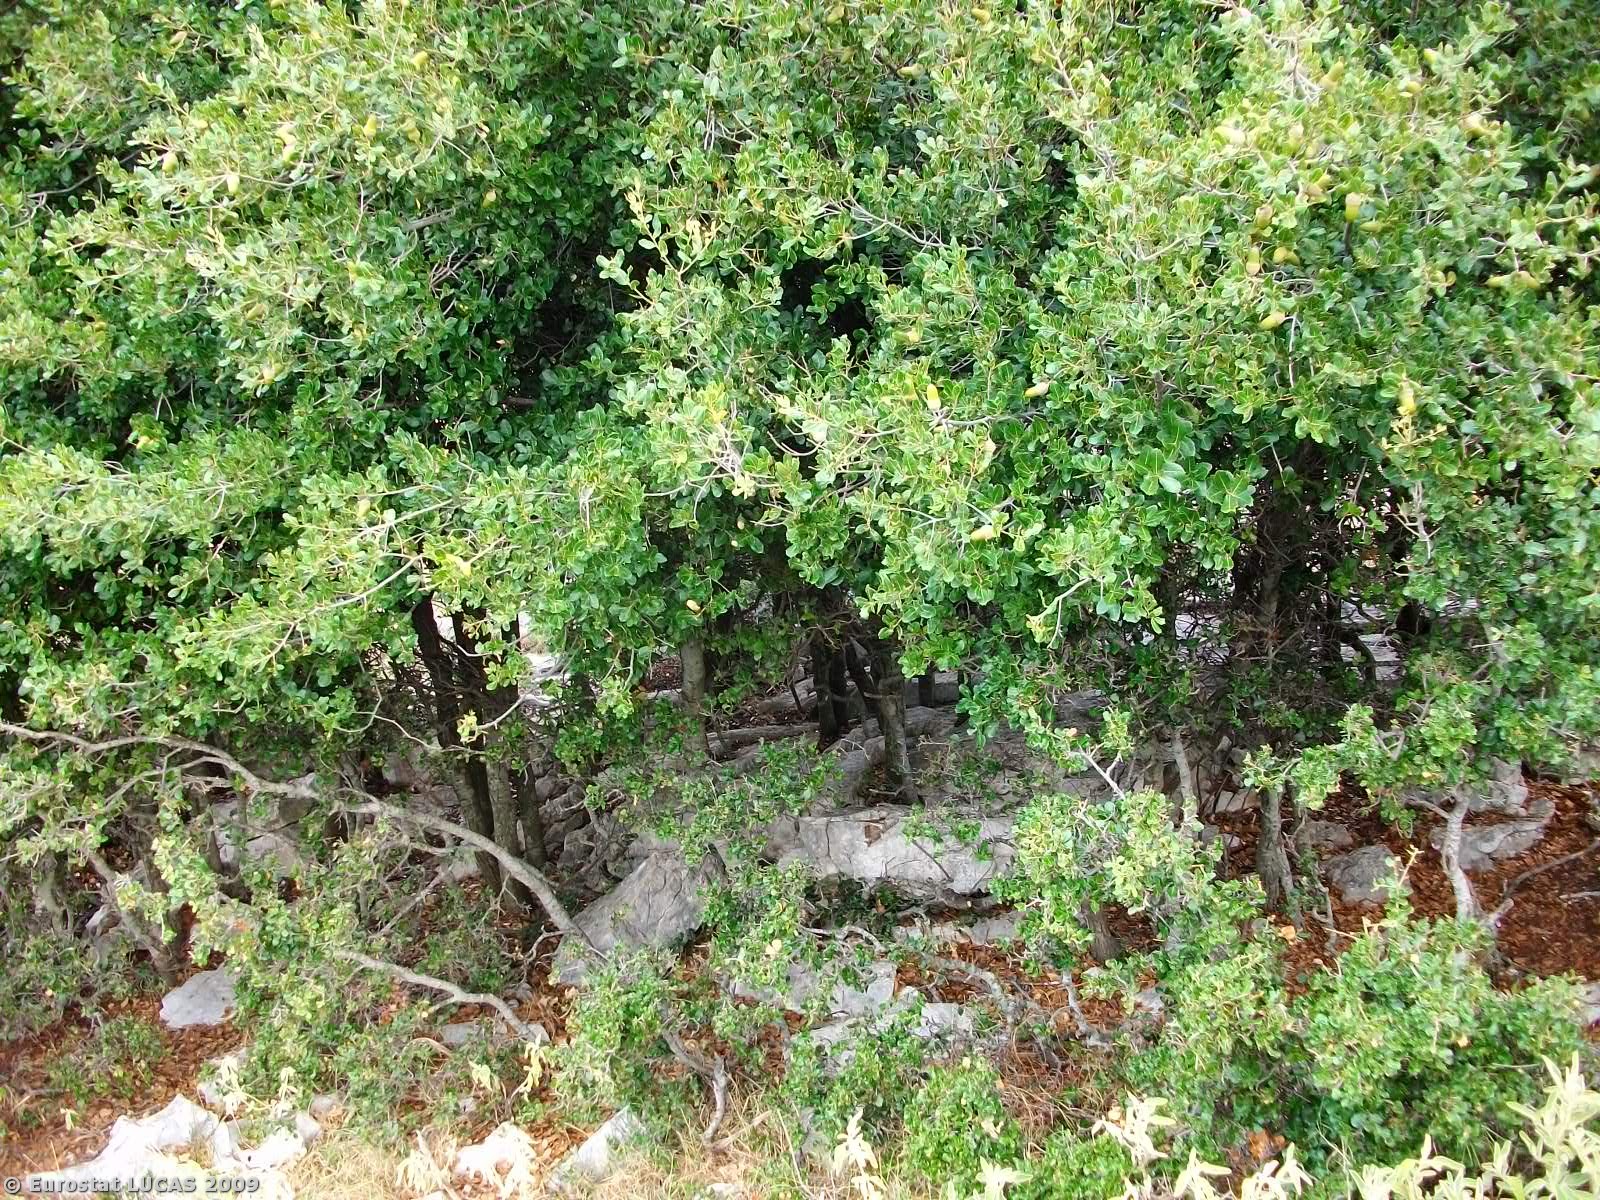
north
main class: Grassland
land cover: Grassland with sparse tree/shrub cover
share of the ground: > 75 %
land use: Unused
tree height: < 5 m
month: October
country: GR
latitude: 39.4146
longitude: 20.4620
